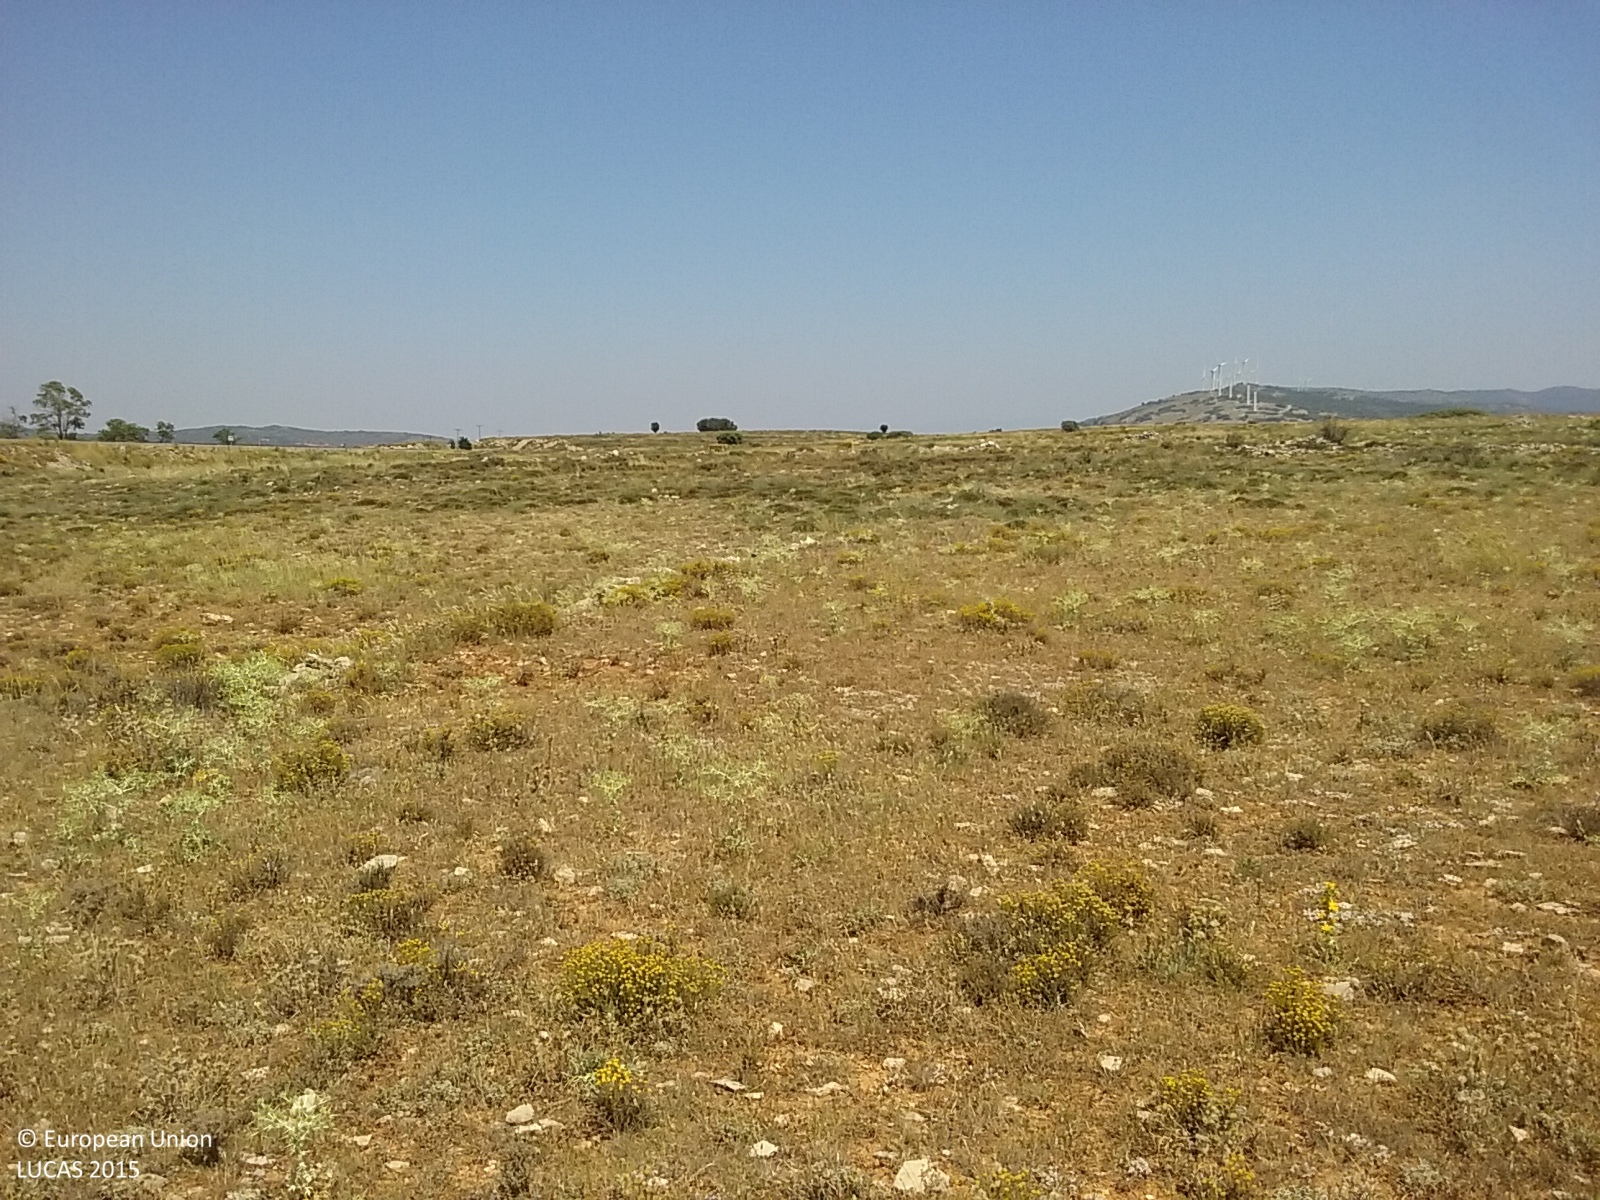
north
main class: Grassland
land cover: Spontaneously vegetated surfaces
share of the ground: 50 - 75 %
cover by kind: herbaceous plants 75 %, unconsolidated bare surface 20 %, shrubs 5 %
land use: Semi-natural and natural areas not in use
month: July
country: ES
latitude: 39.9729
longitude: -0.6941
